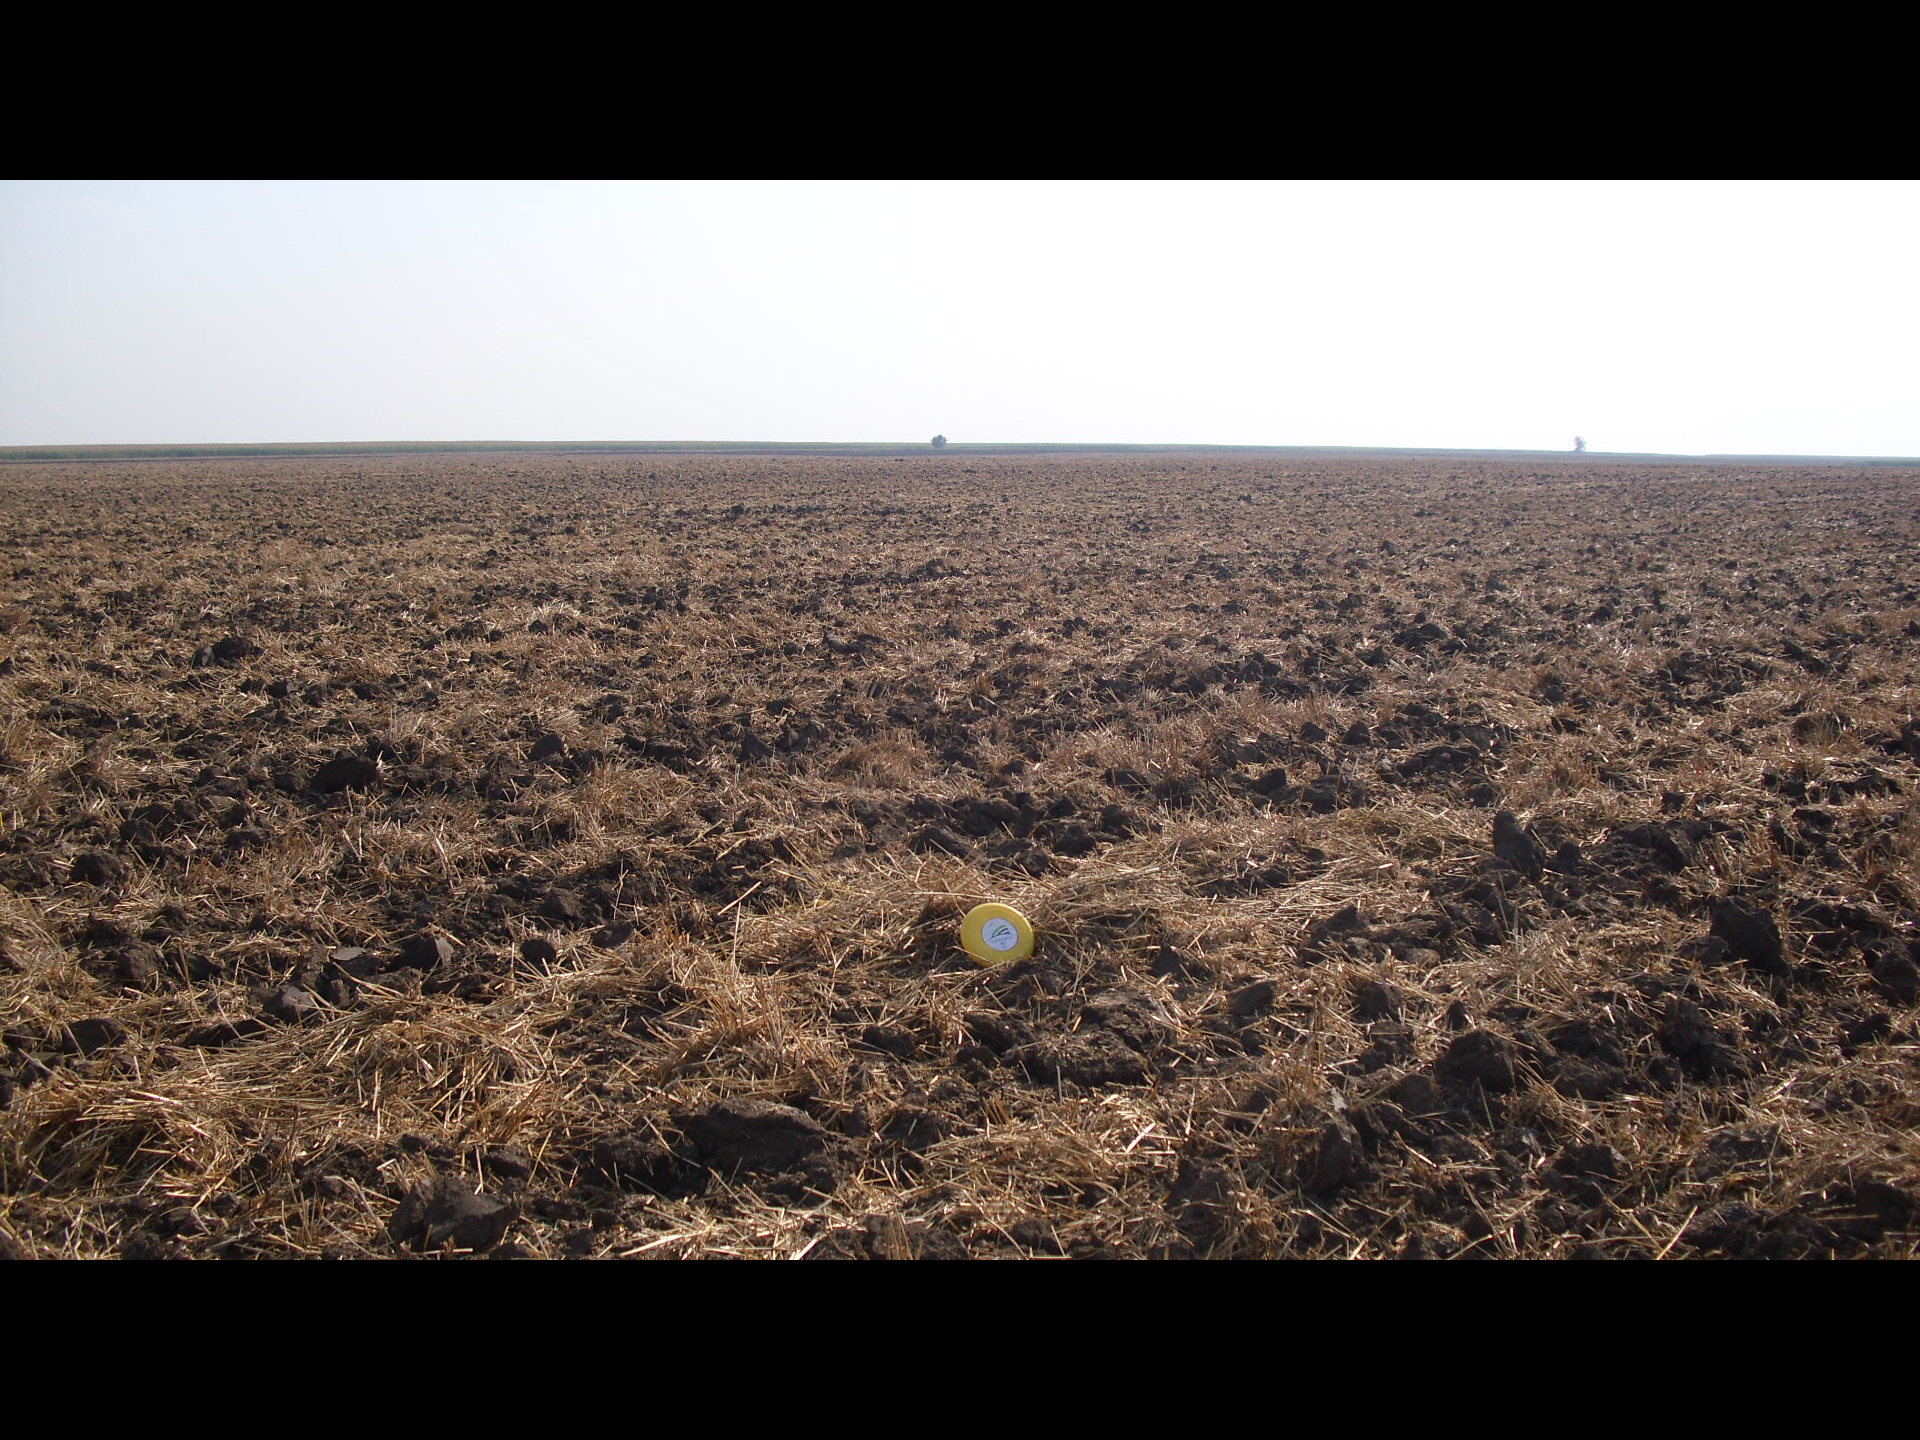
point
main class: Cropland
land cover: Barley
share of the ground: 50 - 75 %
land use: Agriculture (excluding fallow land and kitchen gardens)
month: July
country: BG
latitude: 43.7176
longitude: 23.5140
